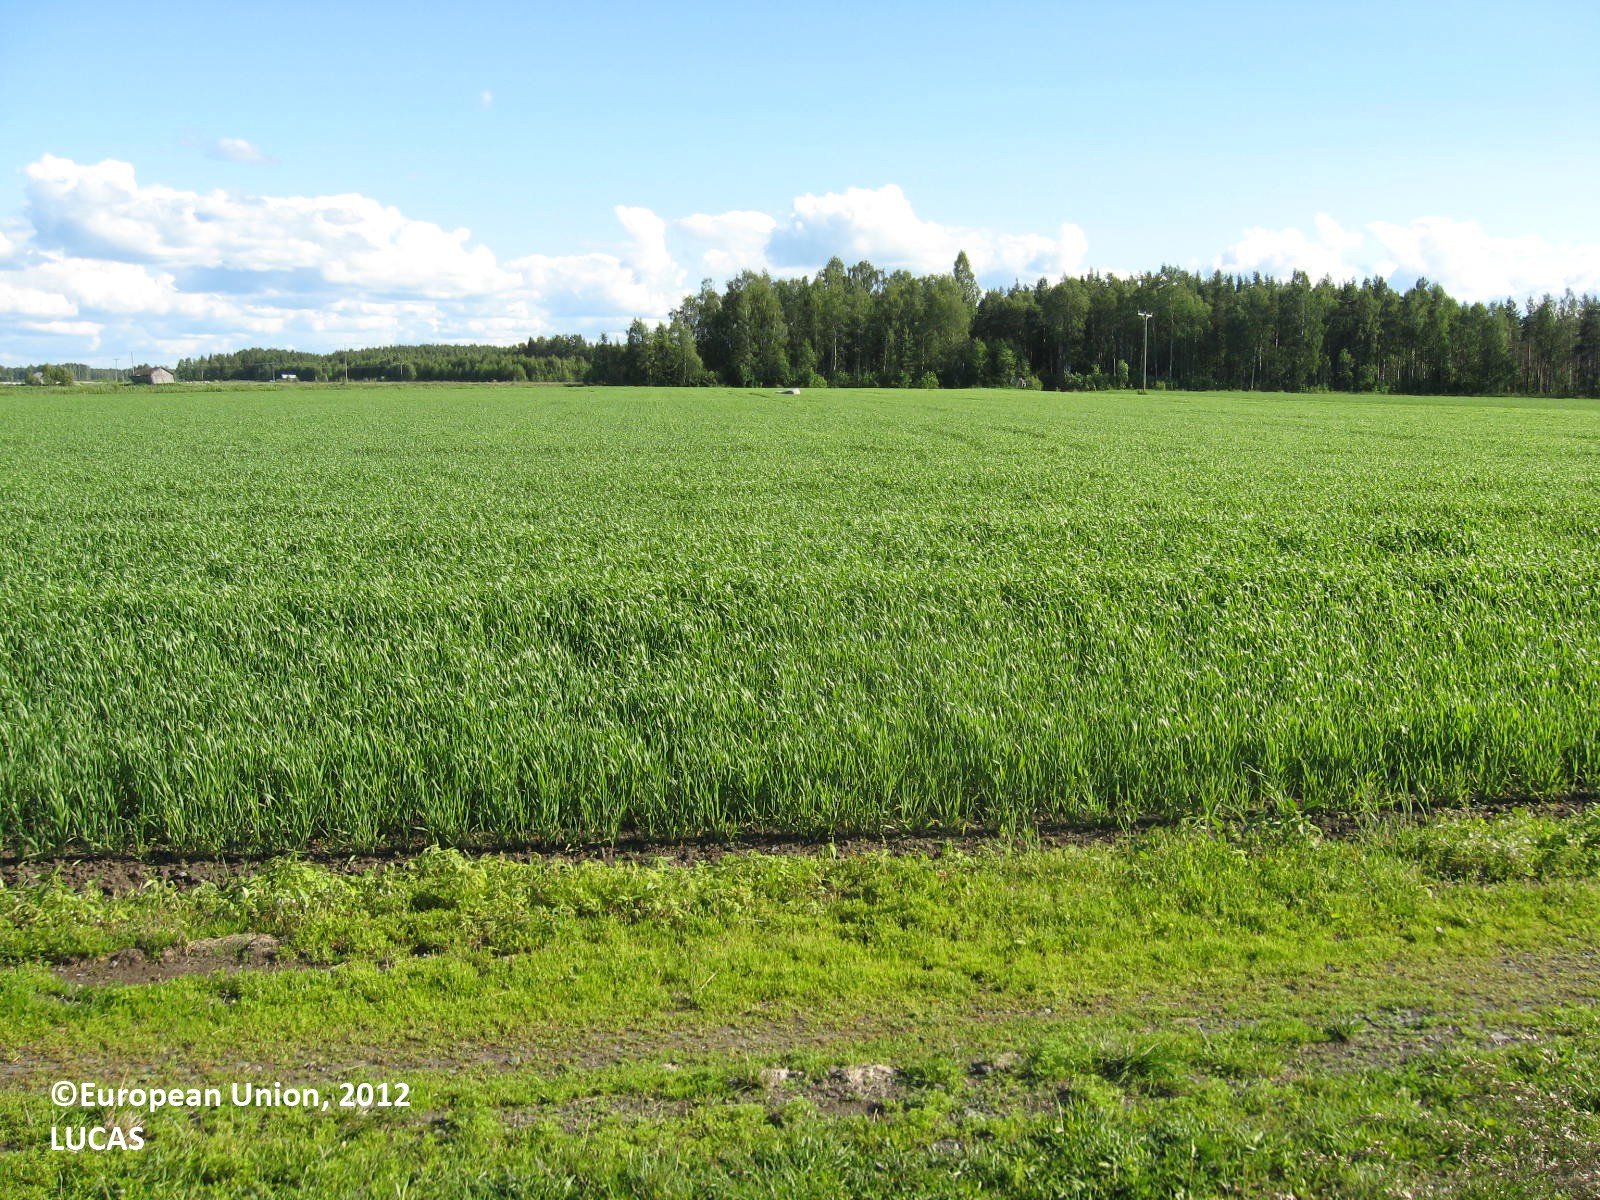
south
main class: Cropland
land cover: Oats
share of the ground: > 75 %
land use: Agriculture (excluding fallow land and kitchen gardens)
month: July
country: FI
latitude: 62.6606
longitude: 22.8829
